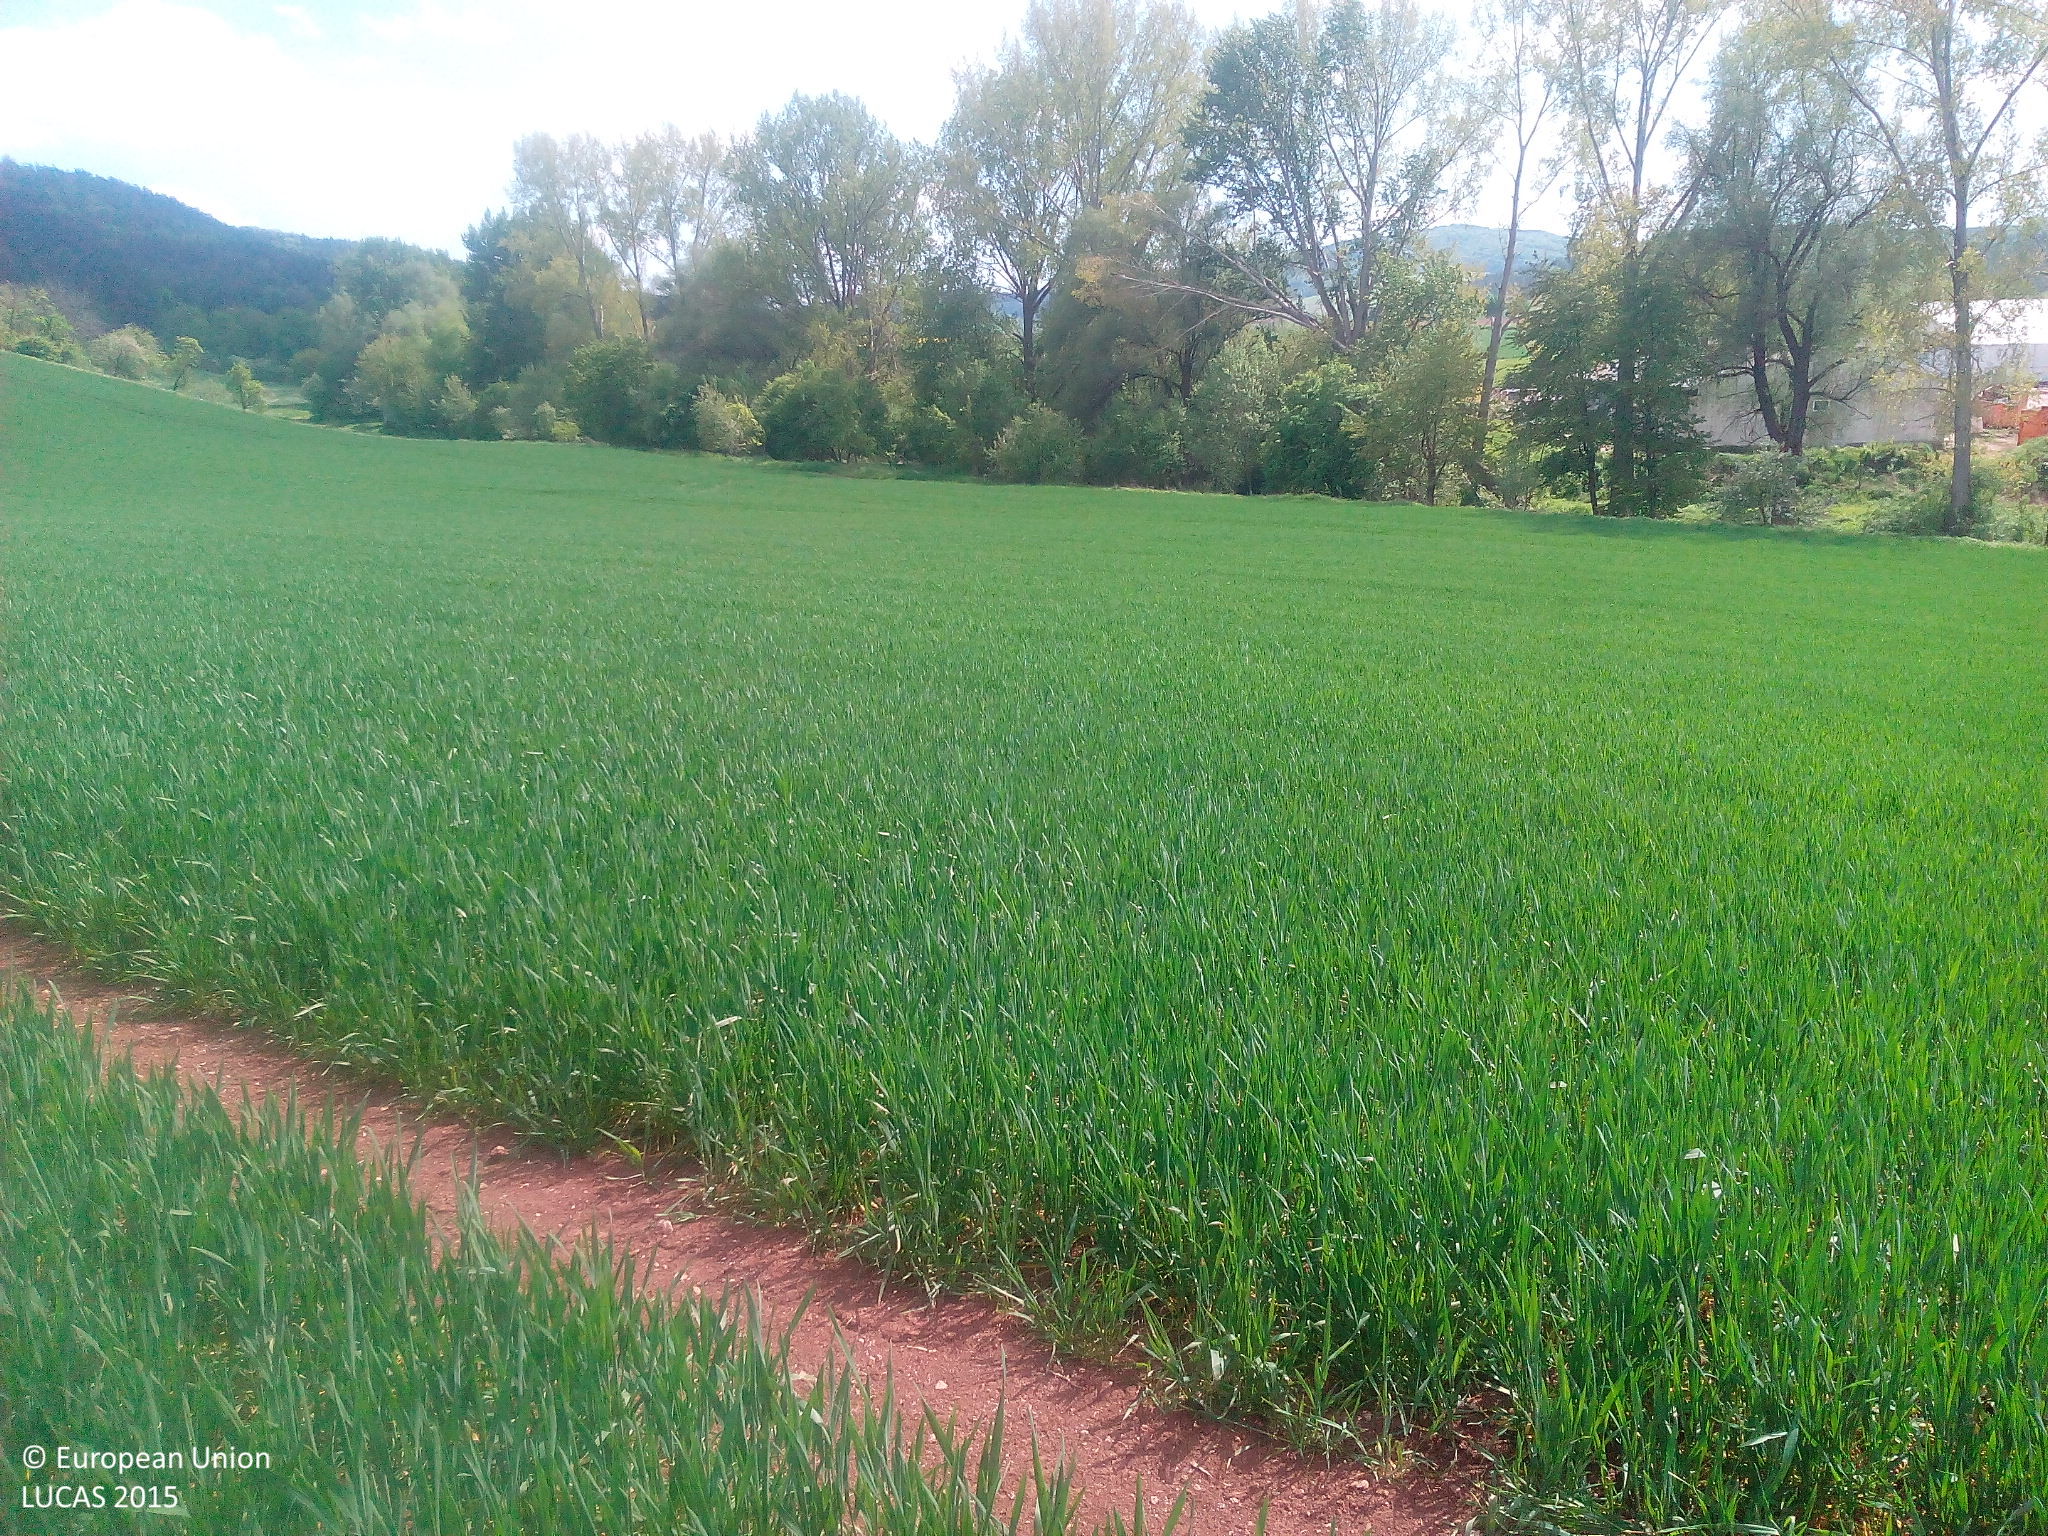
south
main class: Cropland
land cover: Triticale
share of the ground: > 75 %
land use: Agriculture (excluding fallow land and kitchen gardens)
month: May
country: DE
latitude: 51.3708
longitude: 9.9569
